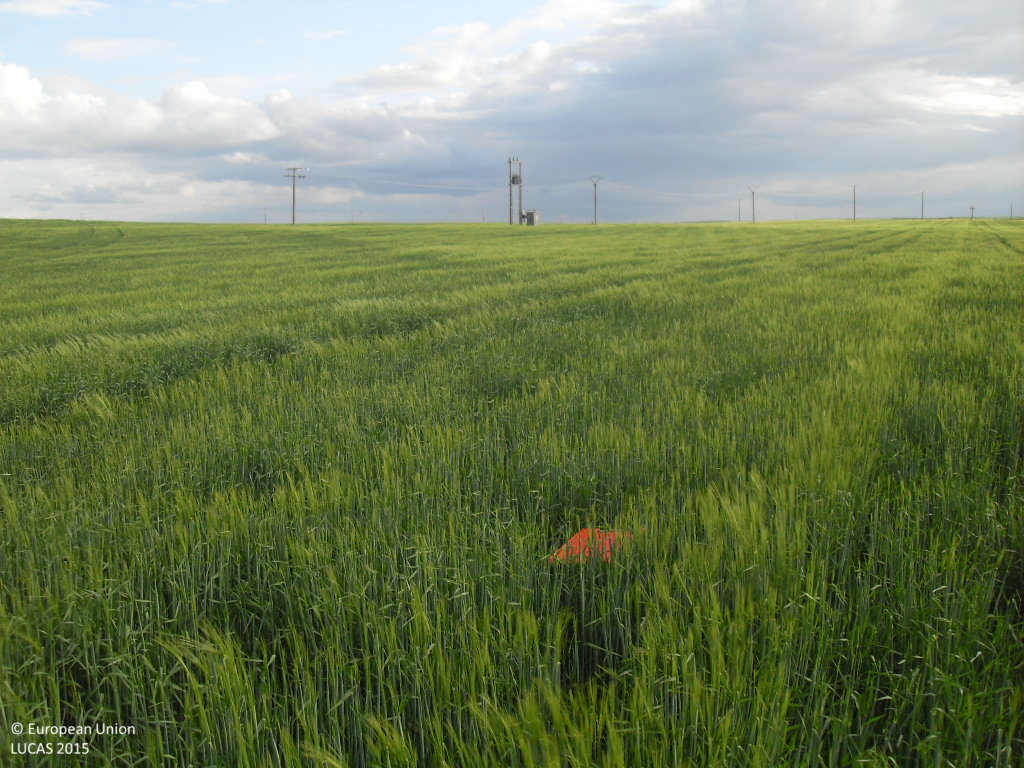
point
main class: Cropland
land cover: Barley
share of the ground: > 75 %
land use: Agriculture (excluding fallow land and kitchen gardens)
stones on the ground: < 10 %
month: April
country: ES
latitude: 41.0067
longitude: -5.1805
